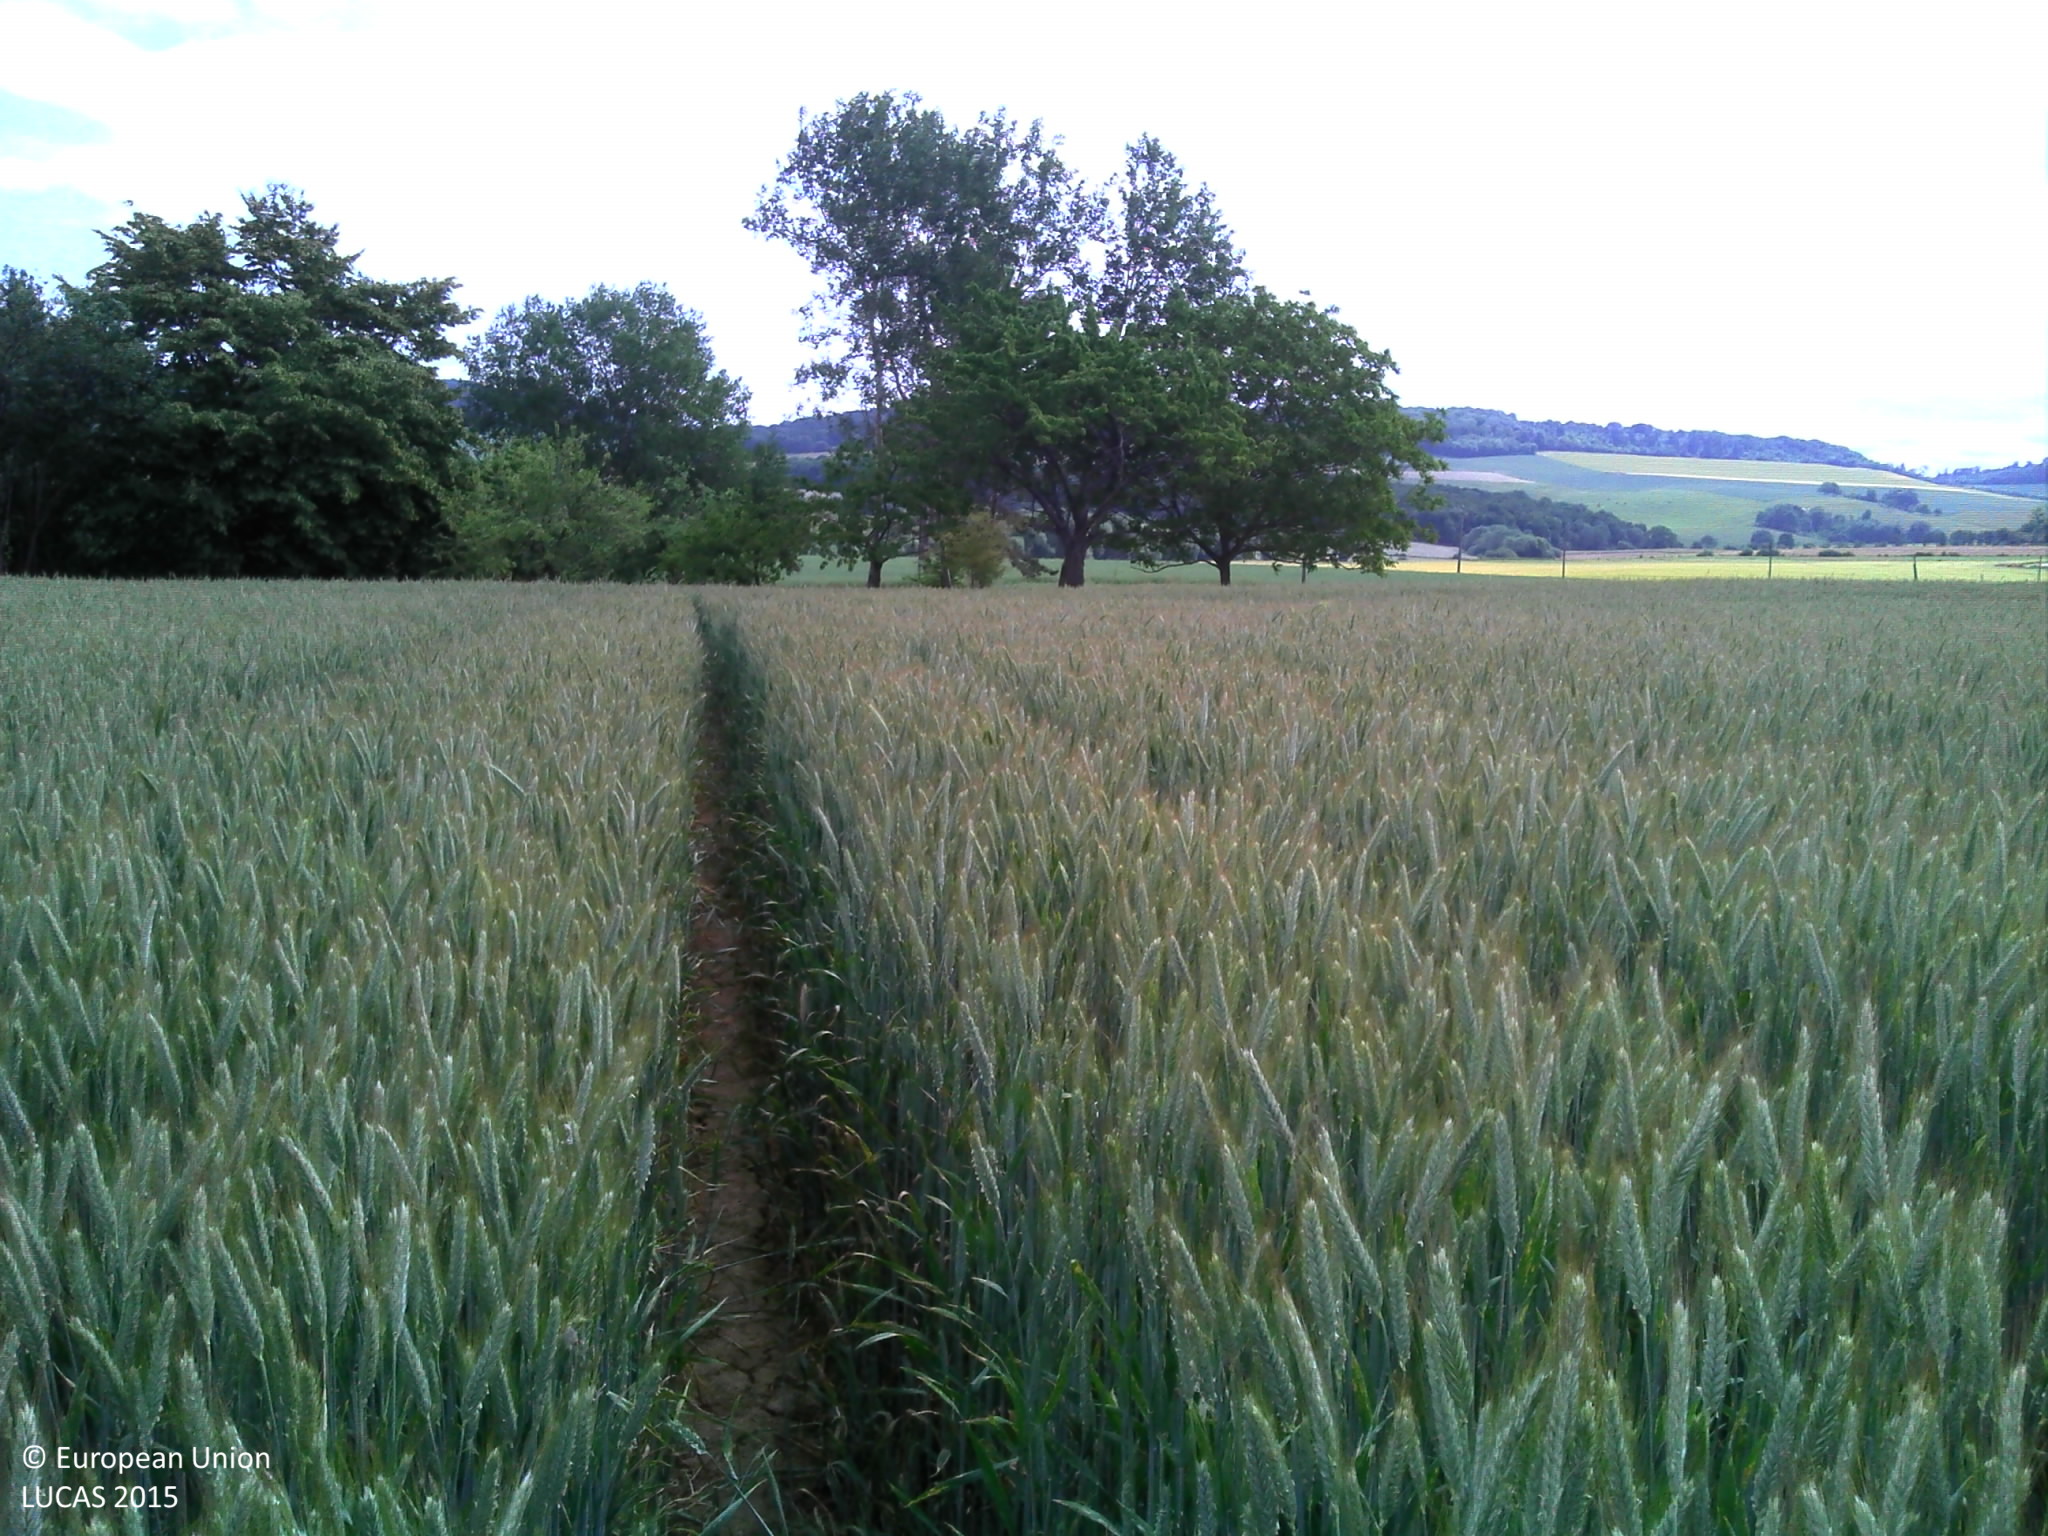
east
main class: Cropland
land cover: Triticale
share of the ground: > 75 %
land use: Agriculture (excluding fallow land and kitchen gardens)
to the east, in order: Triticale; Grassland with sparse tree/shrub cover; Broadleaved woodland; Grass margins; Paved roads, cycling and walking lanes; Grass margins; Grassland without tree/shrub cover; Electric lines; Grassland without tree/shrub cover; Paved roads, cycling and walking lanes; Grass margins; Ditches and canals; Grass margins; Rape and turnip rape
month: June
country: FR
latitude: 48.8245
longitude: 6.1997
